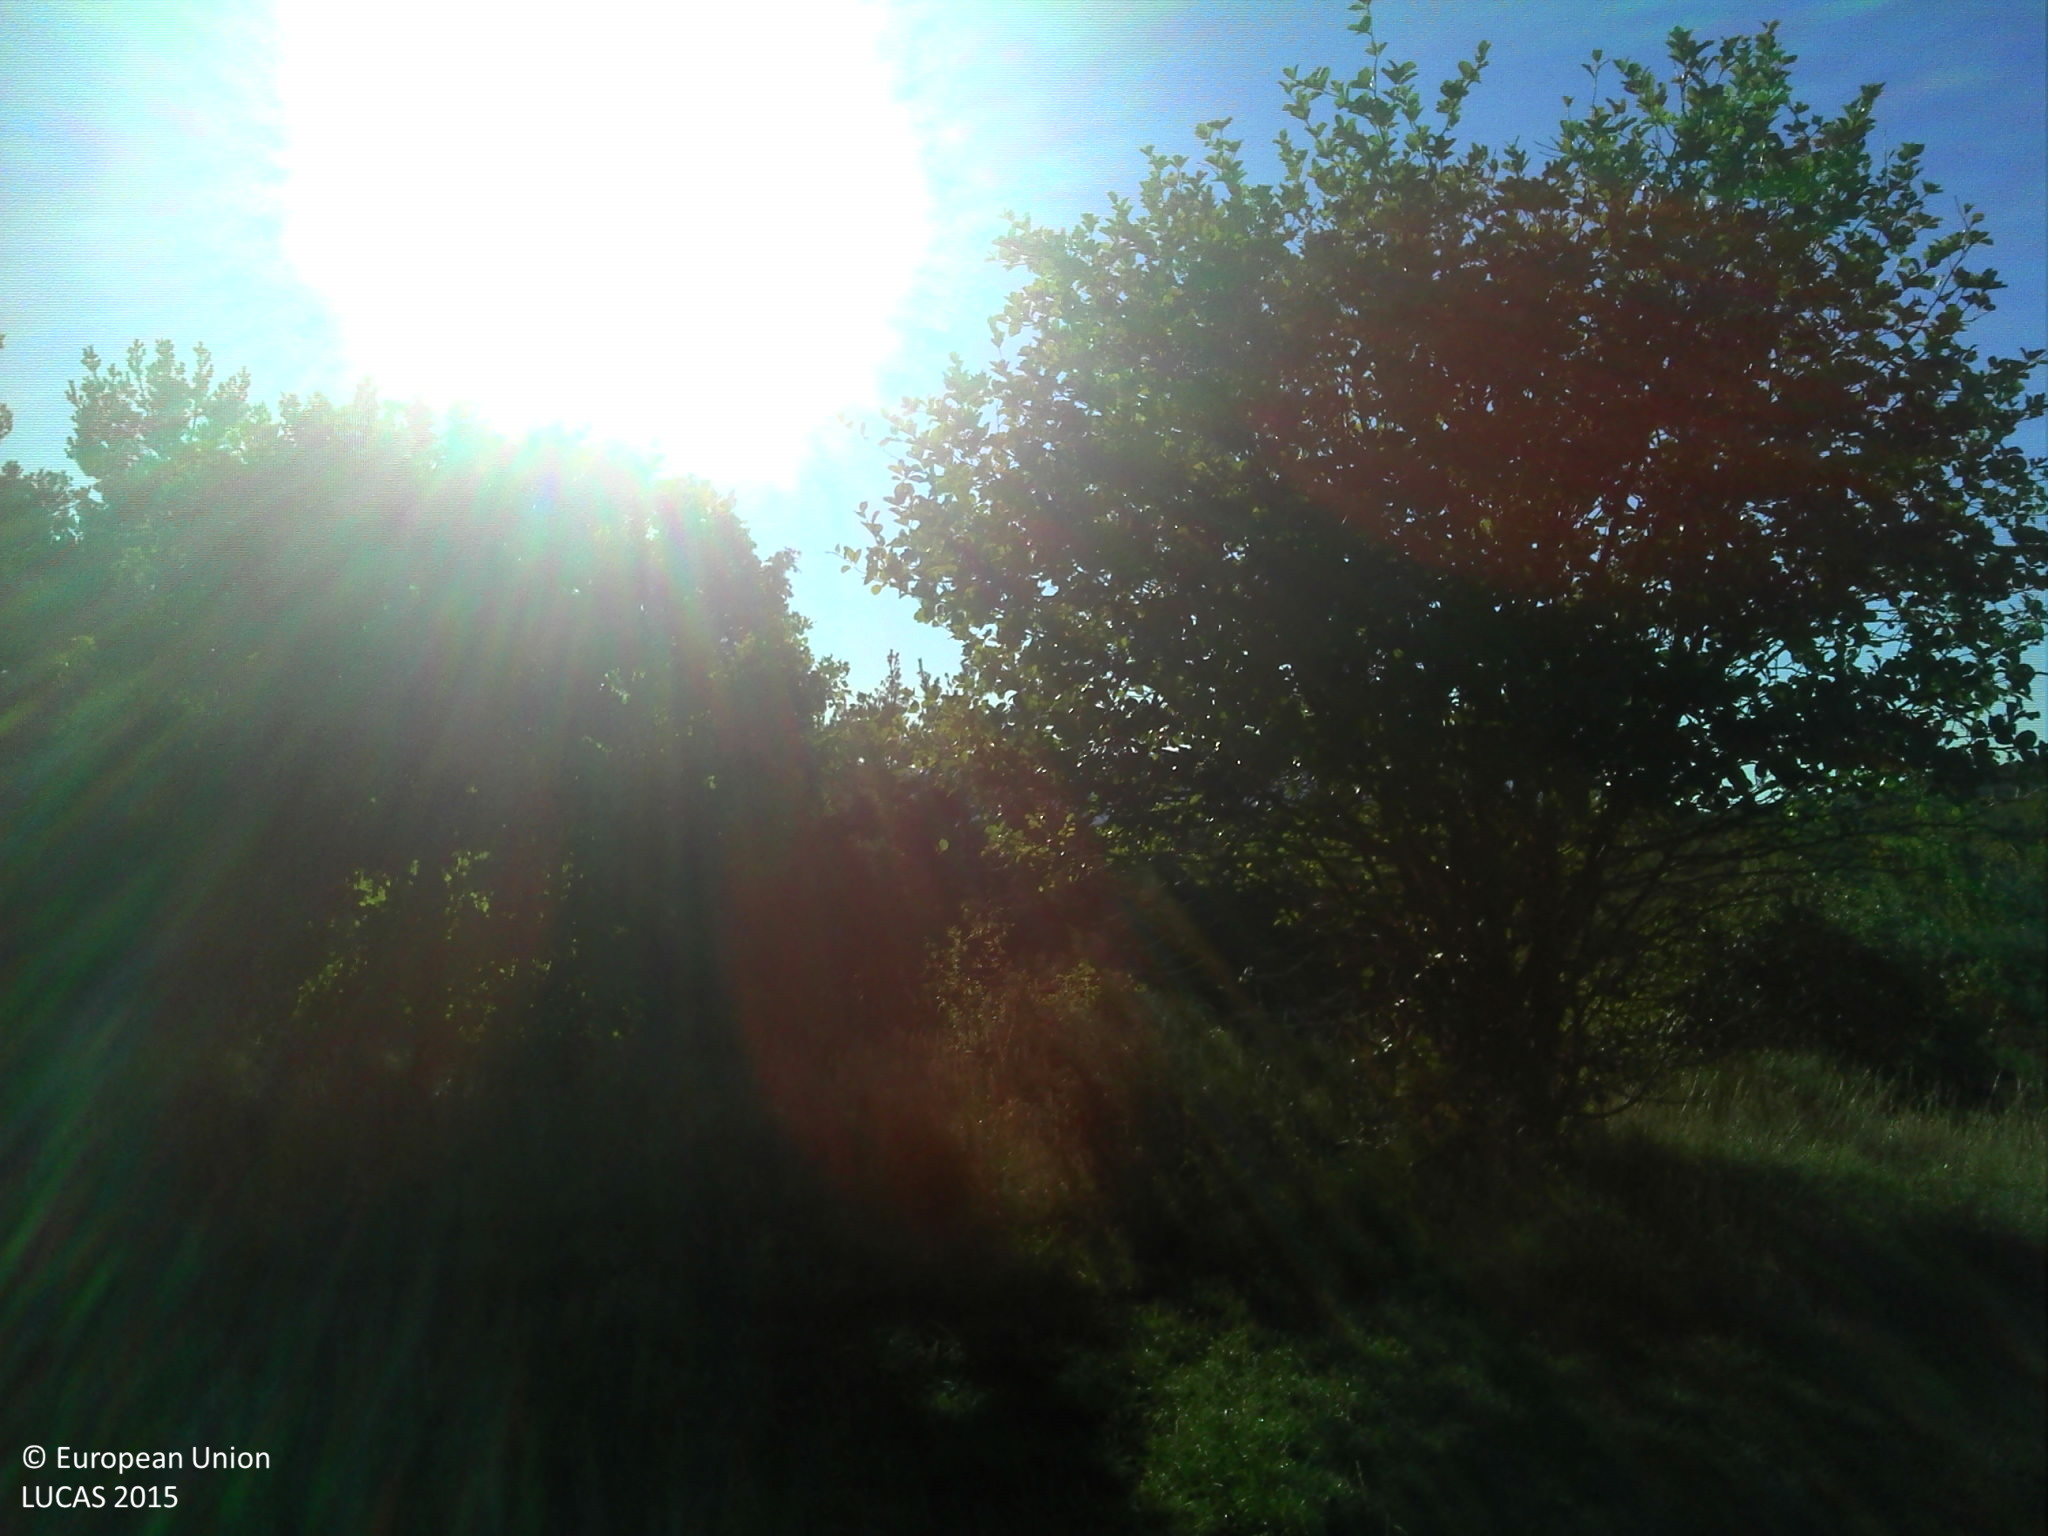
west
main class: Grassland
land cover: Grassland with sparse tree/shrub cover
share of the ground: > 75 %
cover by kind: herbaceous plants 85 %, shrubs 10 %, broadleaved forest trees 5 %
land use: Agriculture (excluding fallow land and kitchen gardens)
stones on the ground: 25 - 50 %
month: September
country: FR
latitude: 44.1455
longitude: 5.5199
